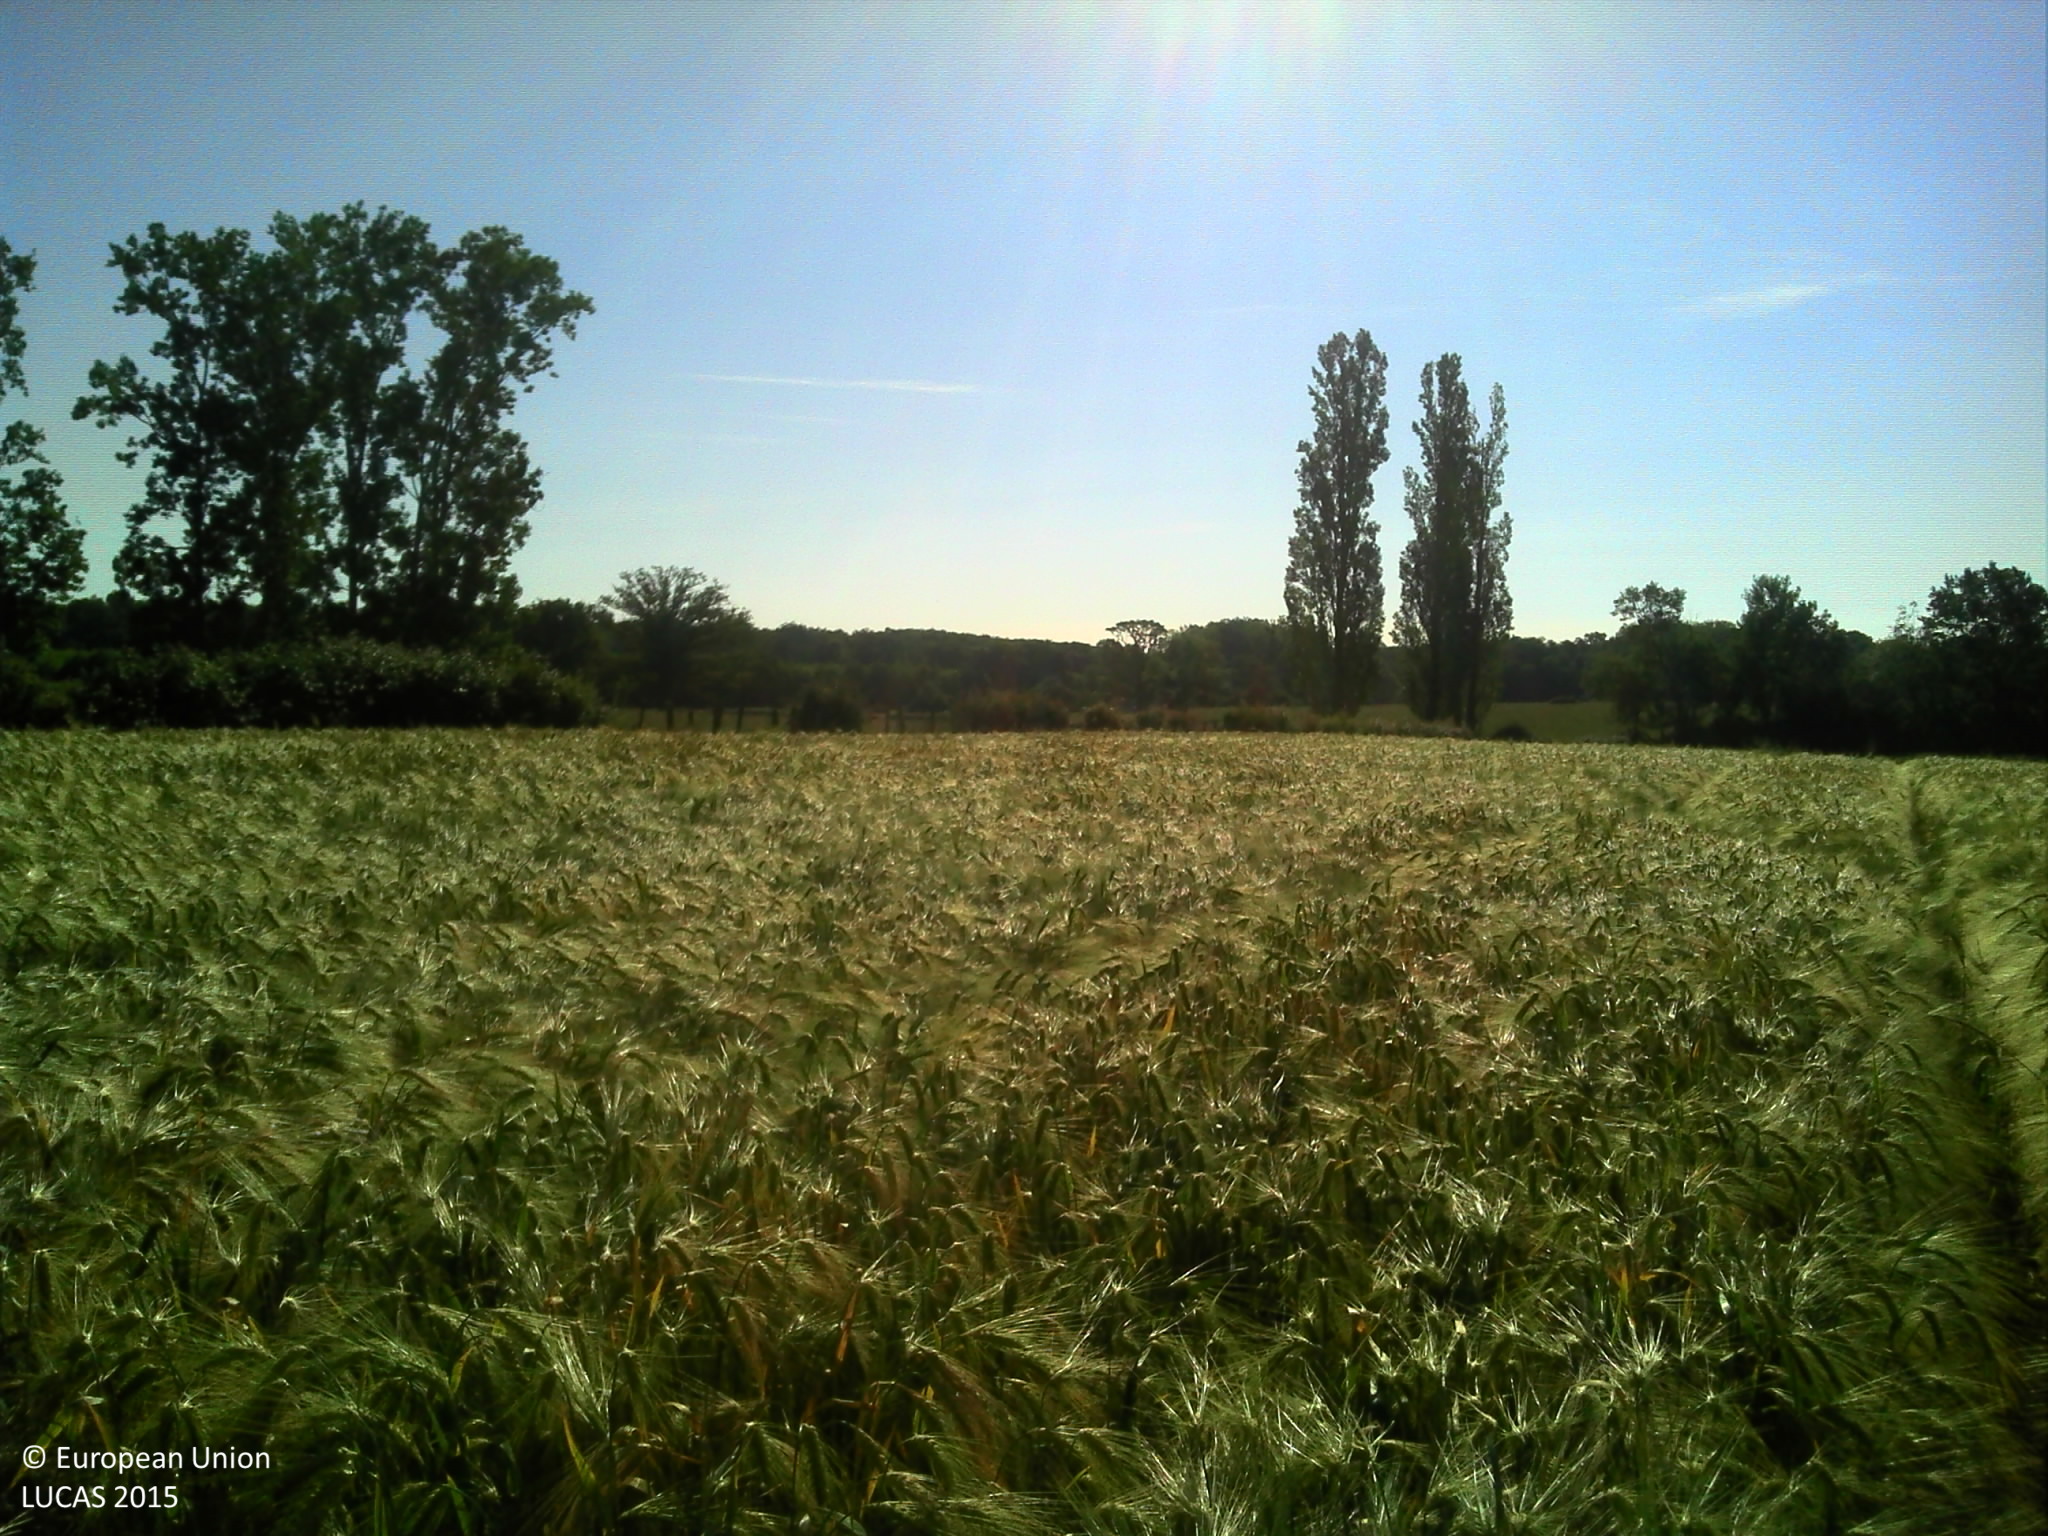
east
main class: Cropland
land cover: Barley
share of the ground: > 75 %
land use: Agriculture (excluding fallow land and kitchen gardens)
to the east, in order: Barley; Abandoned hedges; Fences; Grassland with sparse tree/shrub cover; Managed hedges; Ditches and canals; Grassland without tree/shrub cover
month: June
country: FR
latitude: 46.6263
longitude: 4.8950
